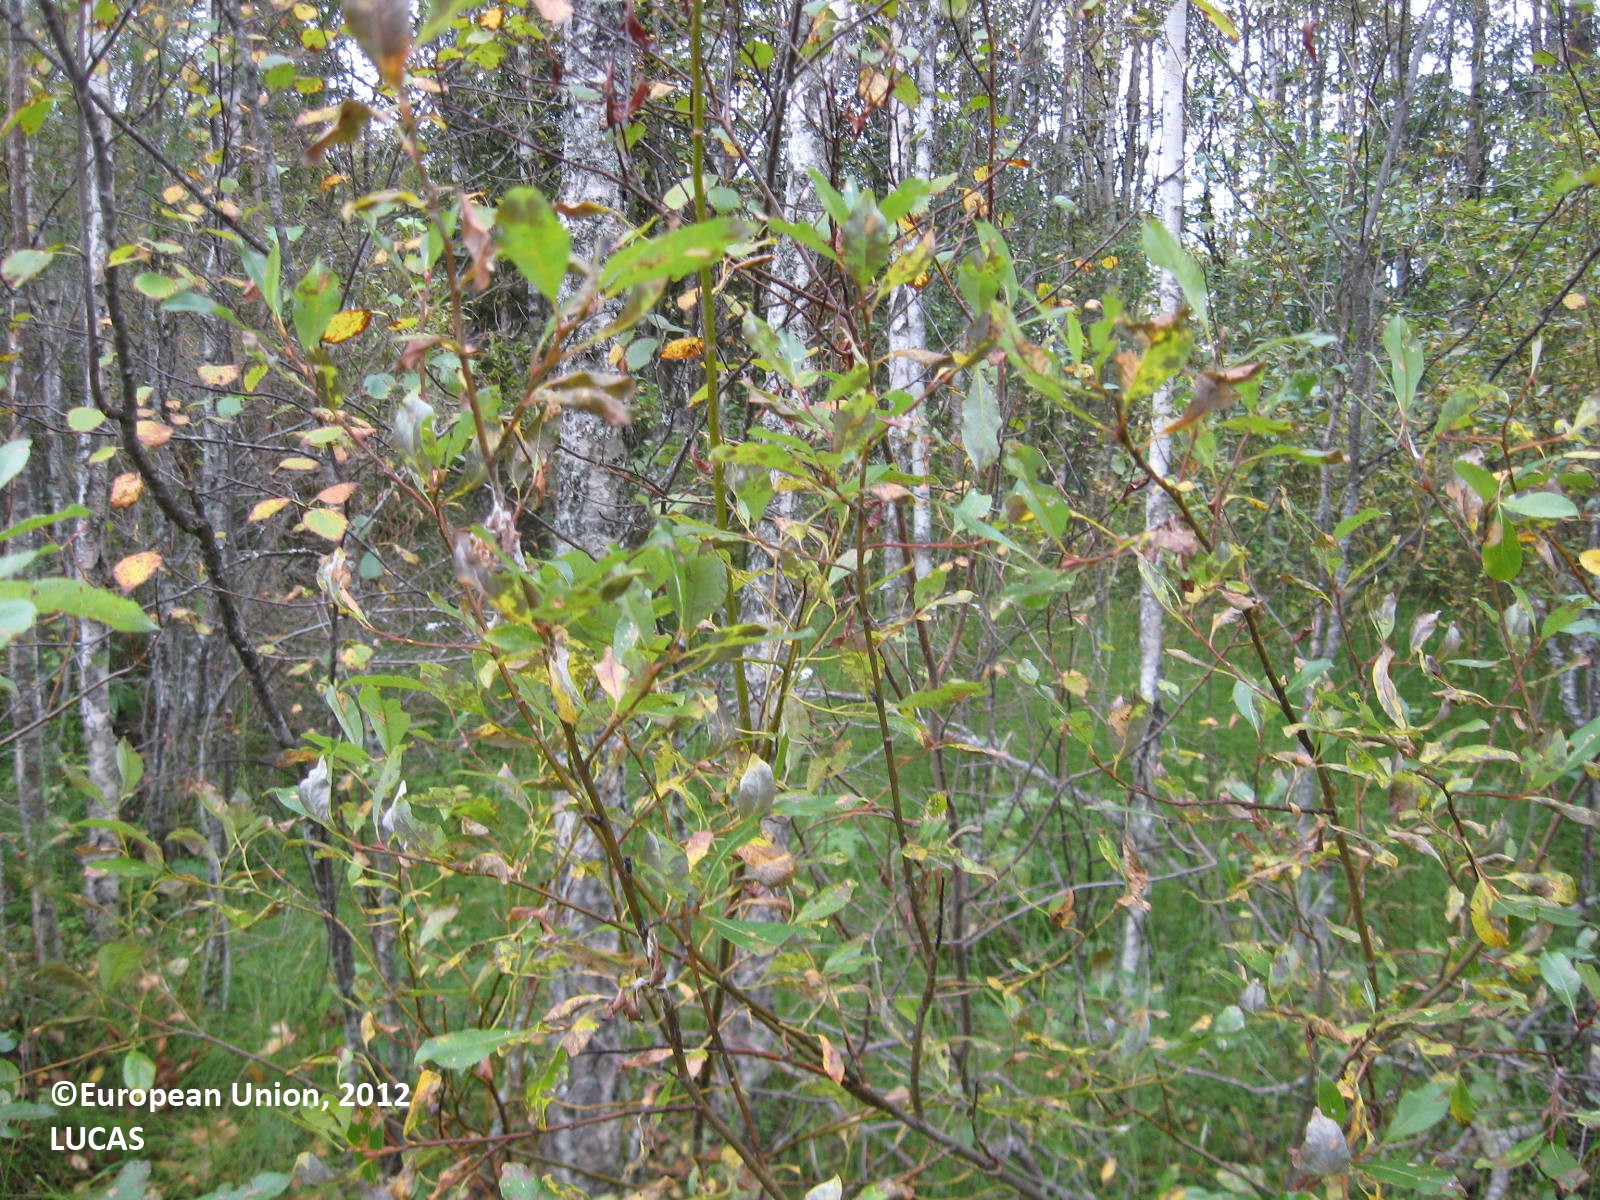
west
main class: Woodland
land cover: Other mixed woodland
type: boreal forest
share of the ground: > 75 %
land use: Forestry
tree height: > 5 m
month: September
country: FI
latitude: 64.0995
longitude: 28.1649
